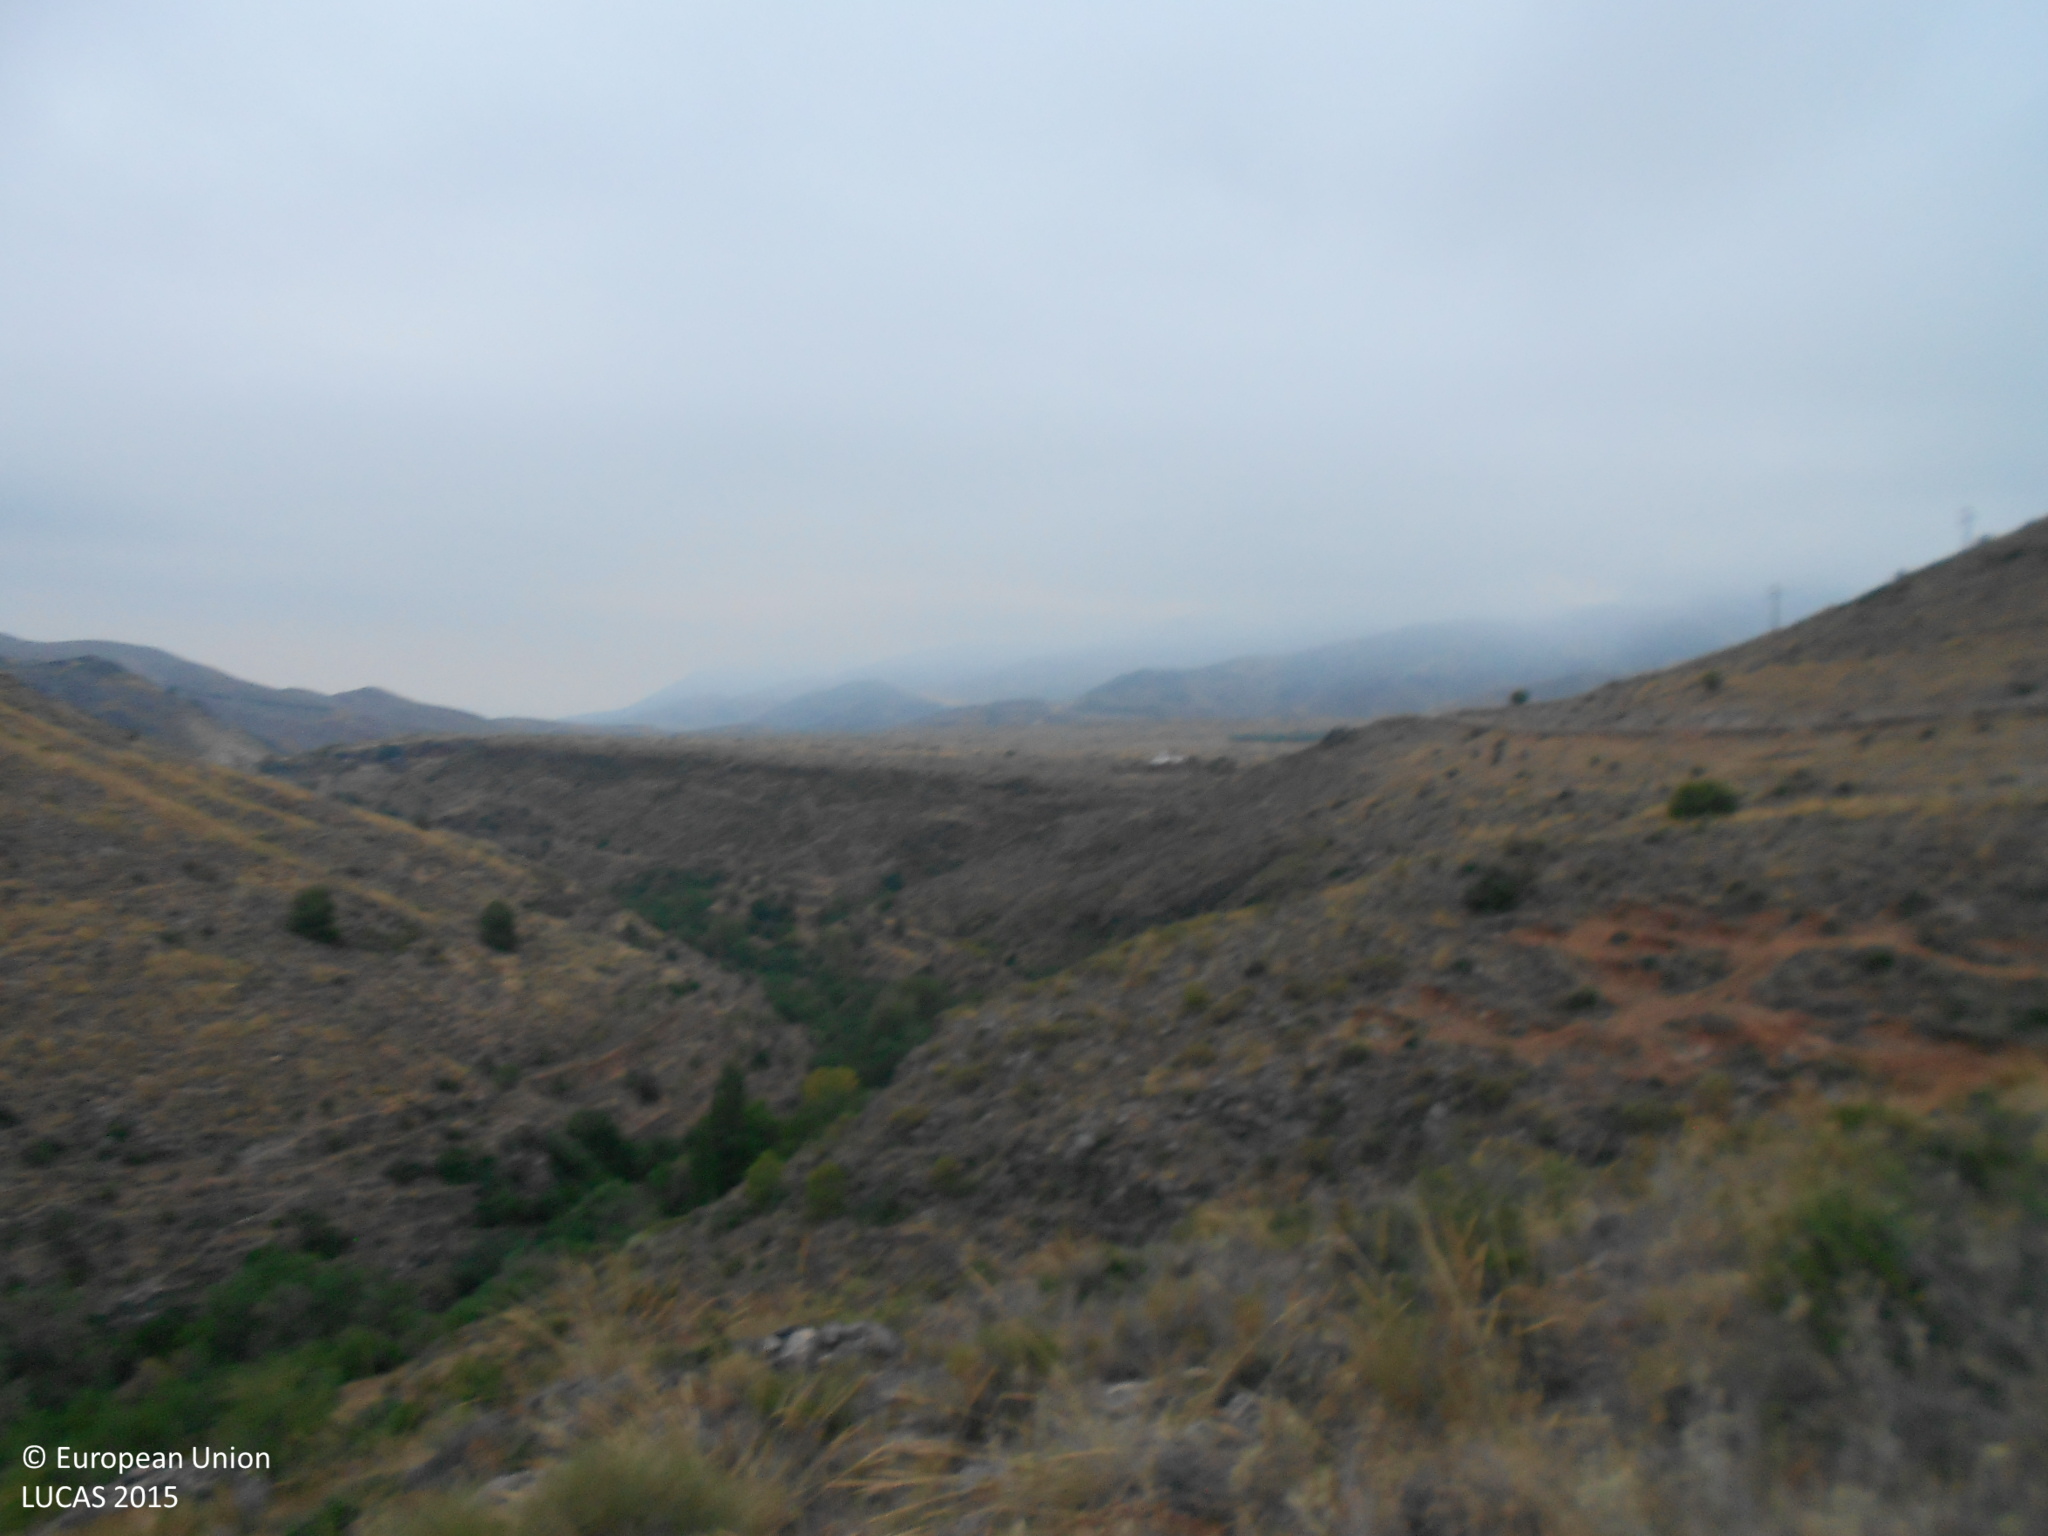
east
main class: Shrubland
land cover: Shrubland without tree cover
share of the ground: 50 - 75 %
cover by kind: shrubs 60 %, herbaceous plants 20 %, consolidated bare surface 20 %
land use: Semi-natural and natural areas not in use
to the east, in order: Shrubland without tree cover; Tracks; Shrubland without tree cover; Nuts trees; Broadleaved woodland; Inland fresh running water; Broadleaved woodland; Shrubland without tree cover
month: July
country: ES
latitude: 36.9858
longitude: -2.8213
